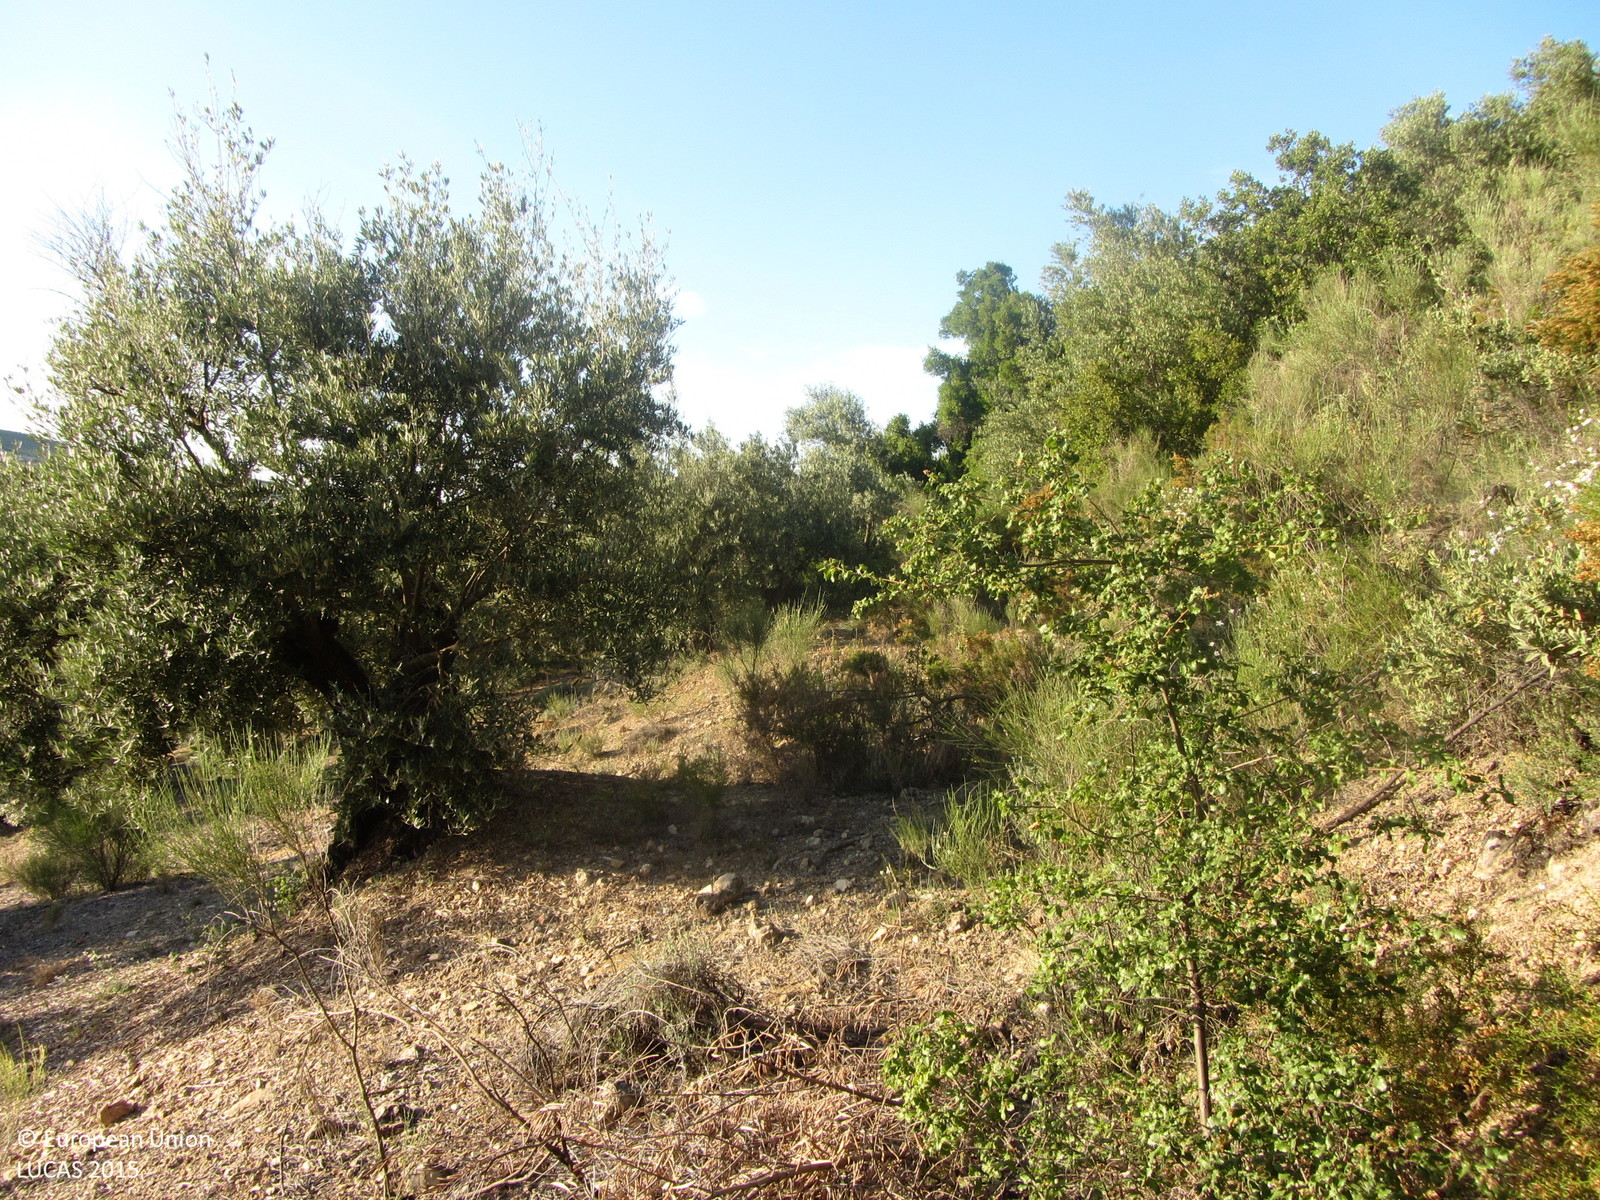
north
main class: Cropland
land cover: Olive groves
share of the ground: 25 - 50 %
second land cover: Spontaneously vegetated surfaces
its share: 10 - 25 %
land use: Agriculture (excluding fallow land and kitchen gardens)
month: May
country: ES
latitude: 38.1325
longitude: -3.0156
